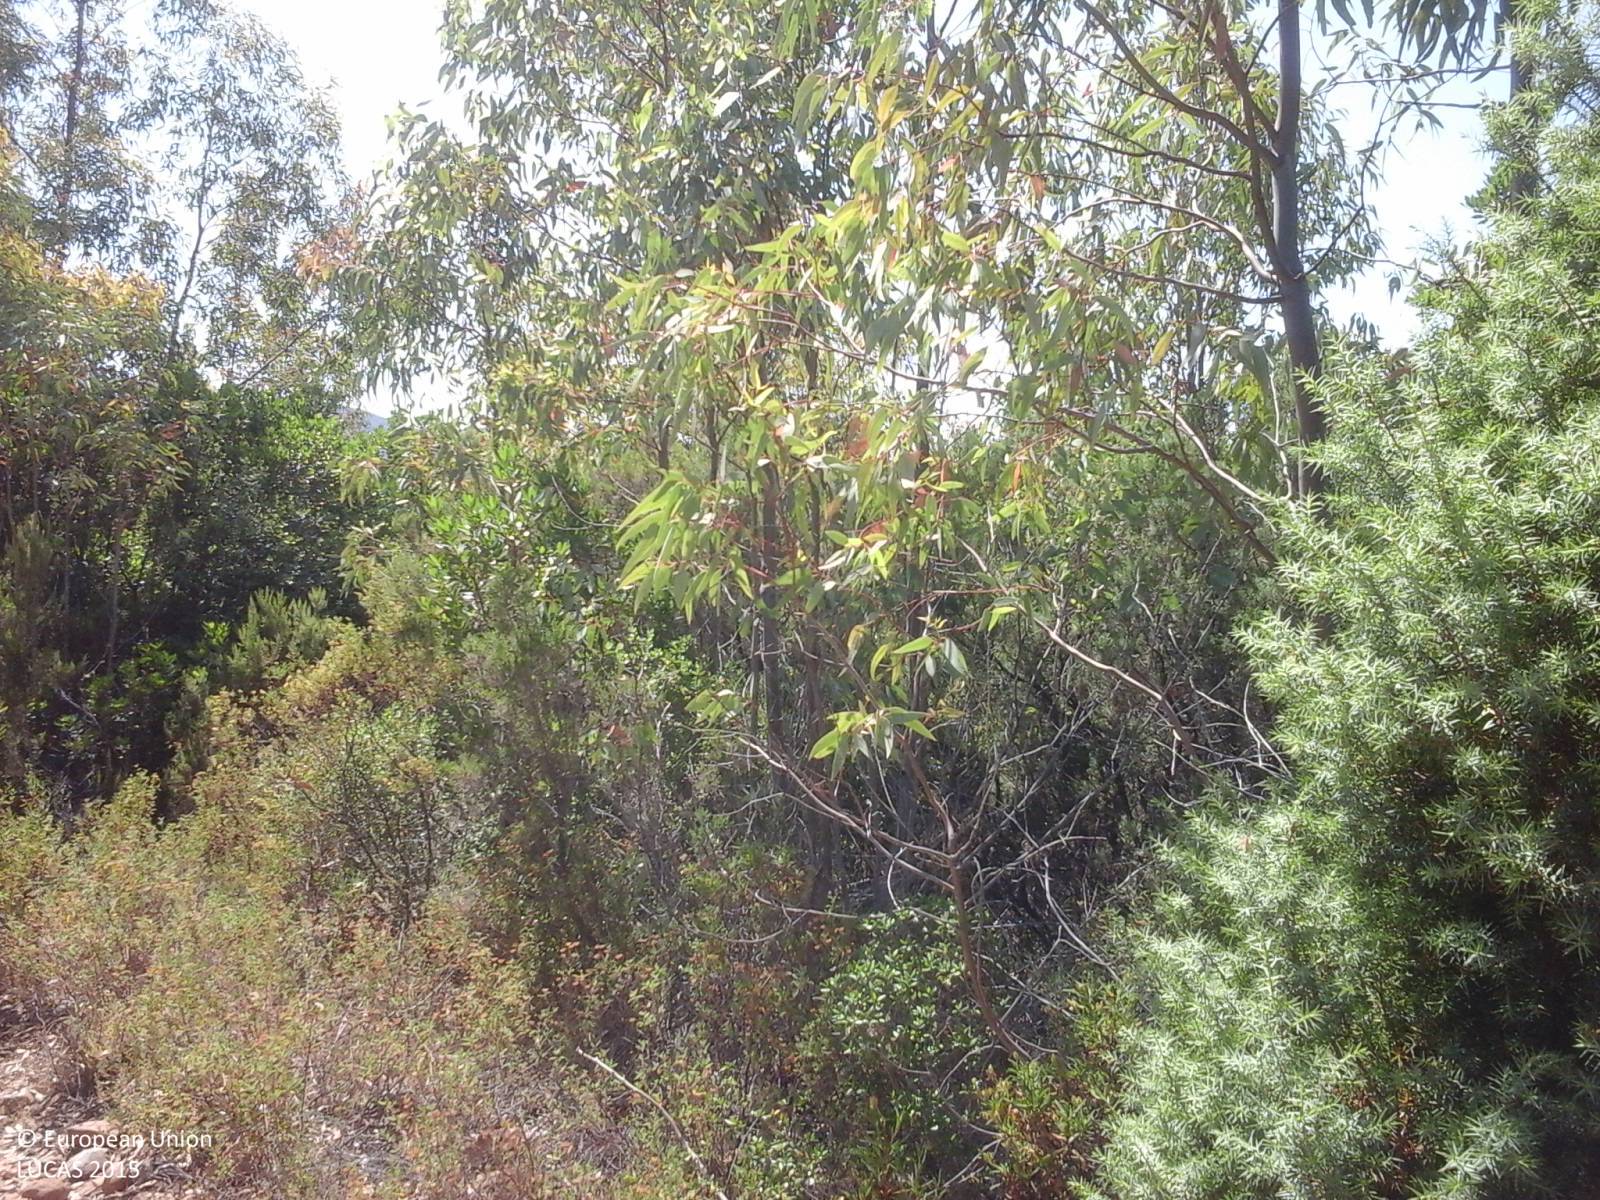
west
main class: Shrubland
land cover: Shrubland with sparse tree cover
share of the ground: > 75 %
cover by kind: shrubs 95 %, broadleaved forest trees 5 %
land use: Semi-natural and natural areas not in use
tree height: < 5 m
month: June
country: IT
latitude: 39.2098
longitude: 8.8376
